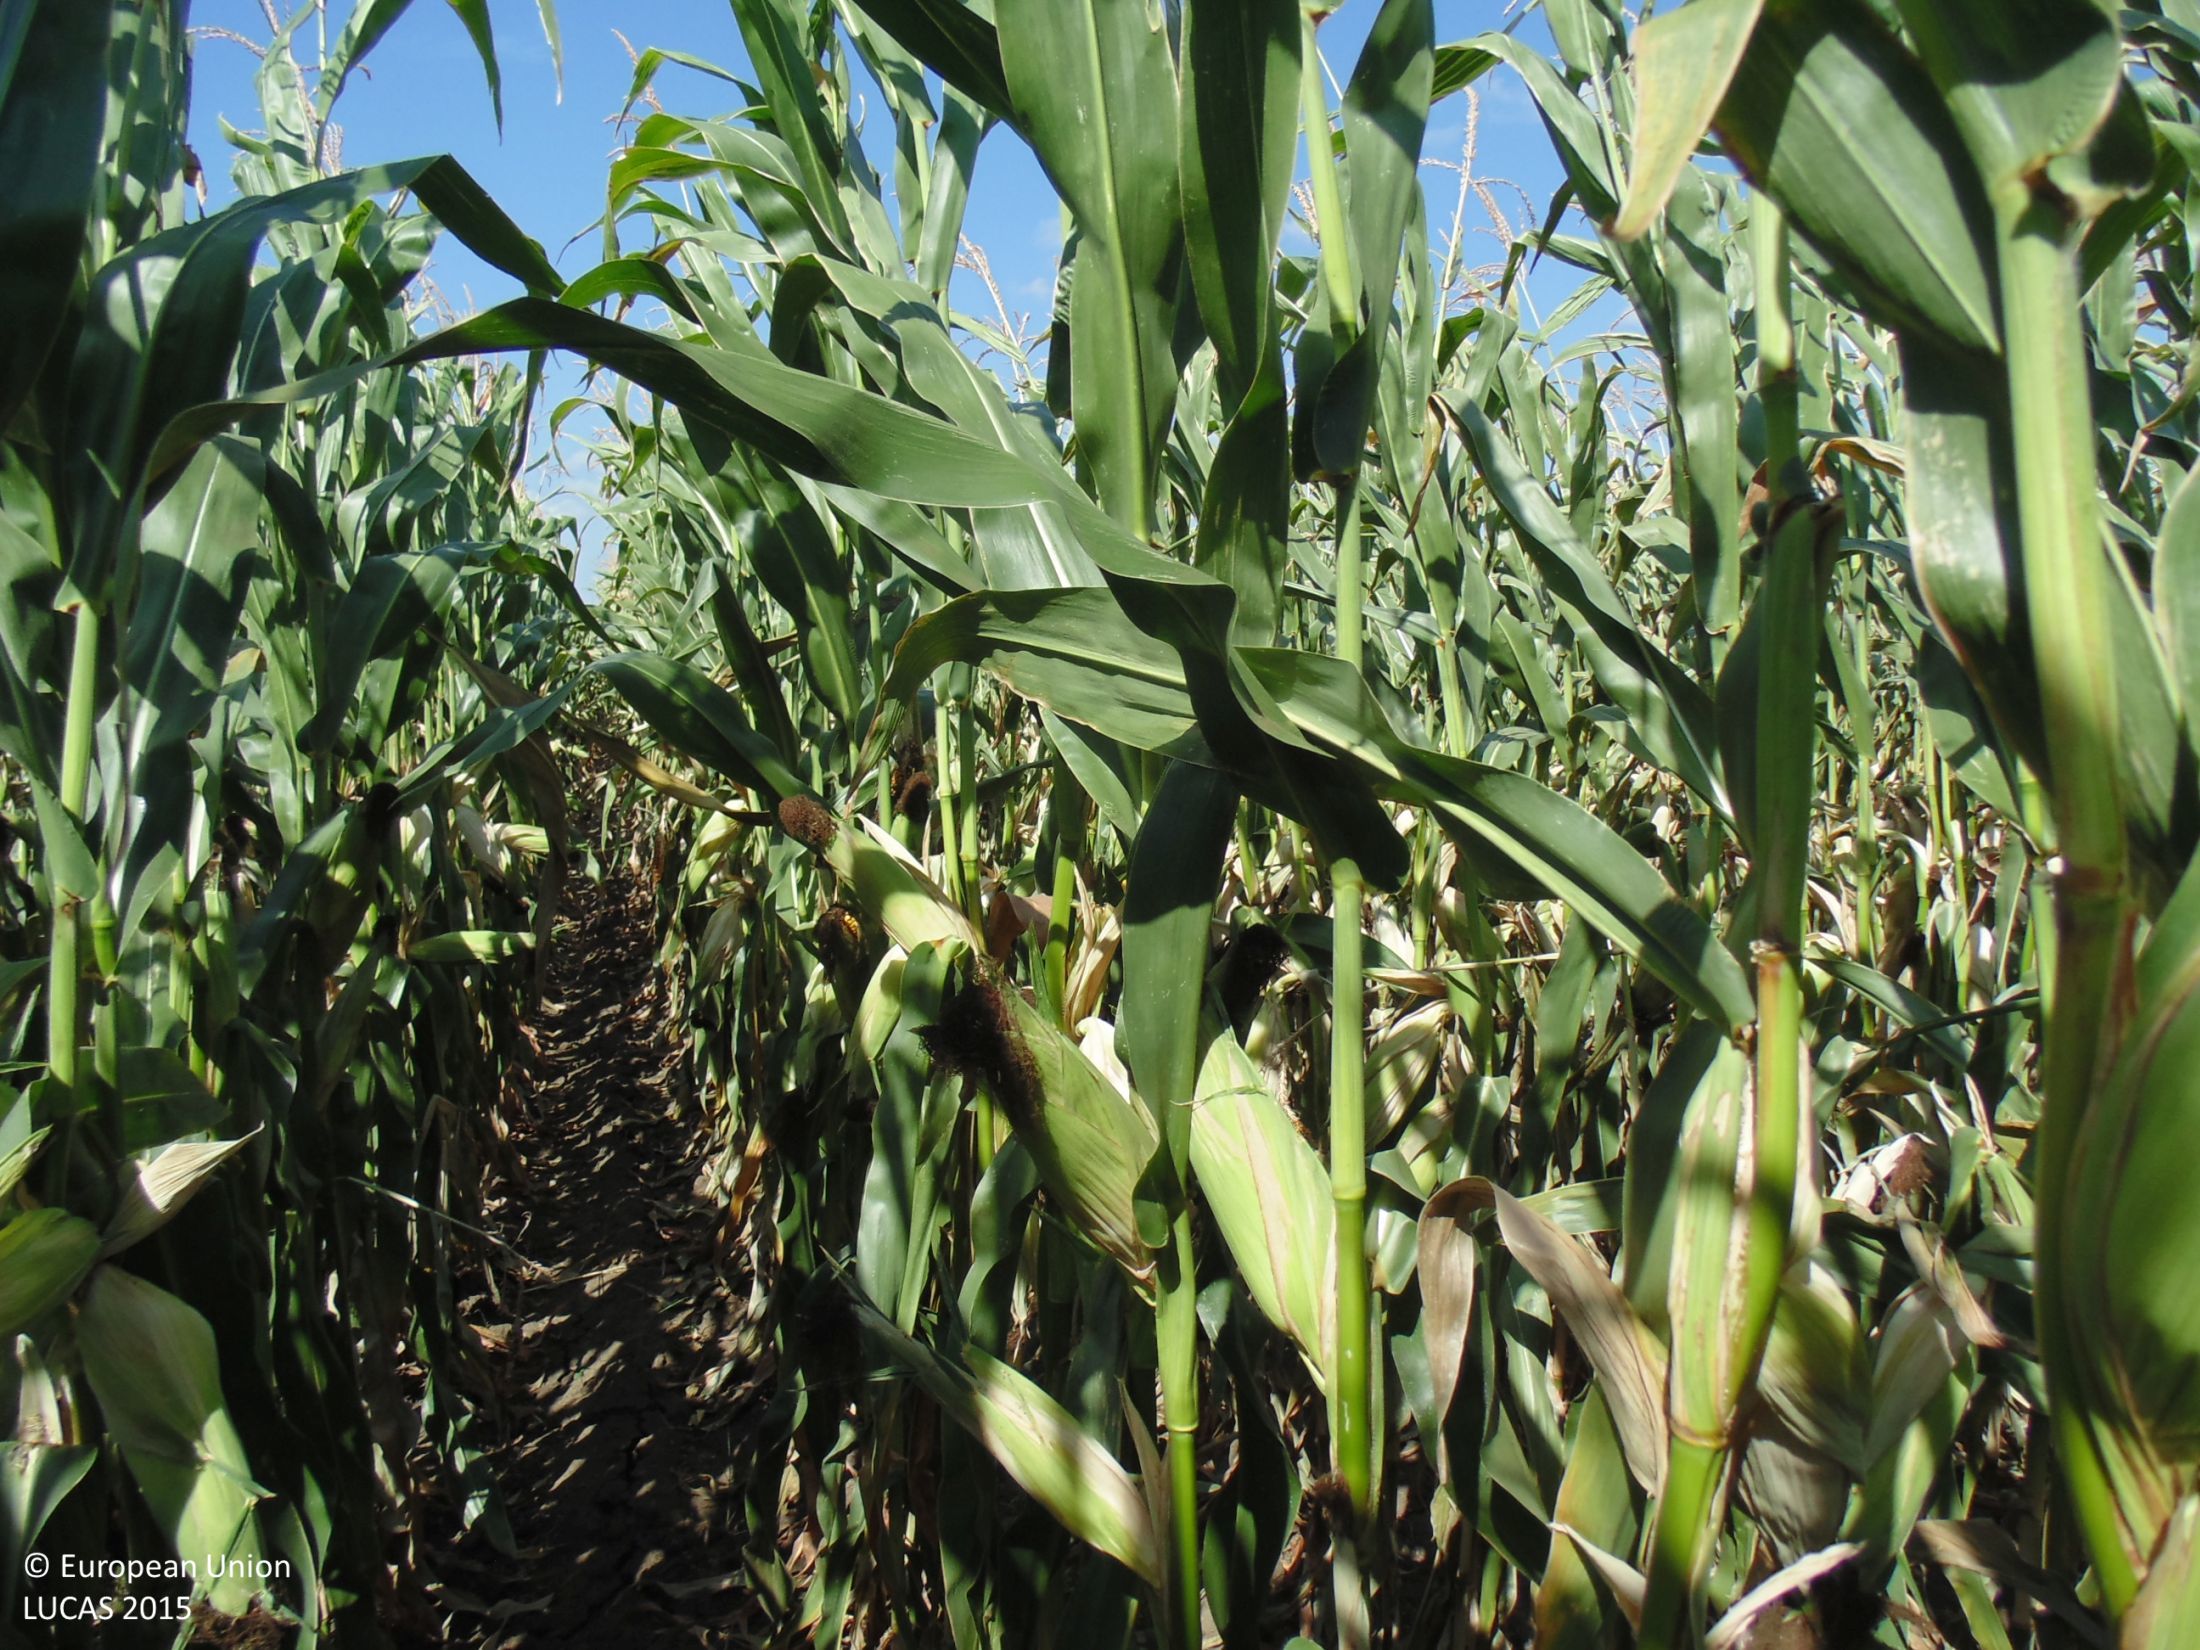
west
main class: Cropland
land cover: Maize
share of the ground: > 75 %
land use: Agriculture (excluding fallow land and kitchen gardens)
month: August
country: BG
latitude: 43.6615
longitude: 28.2221
